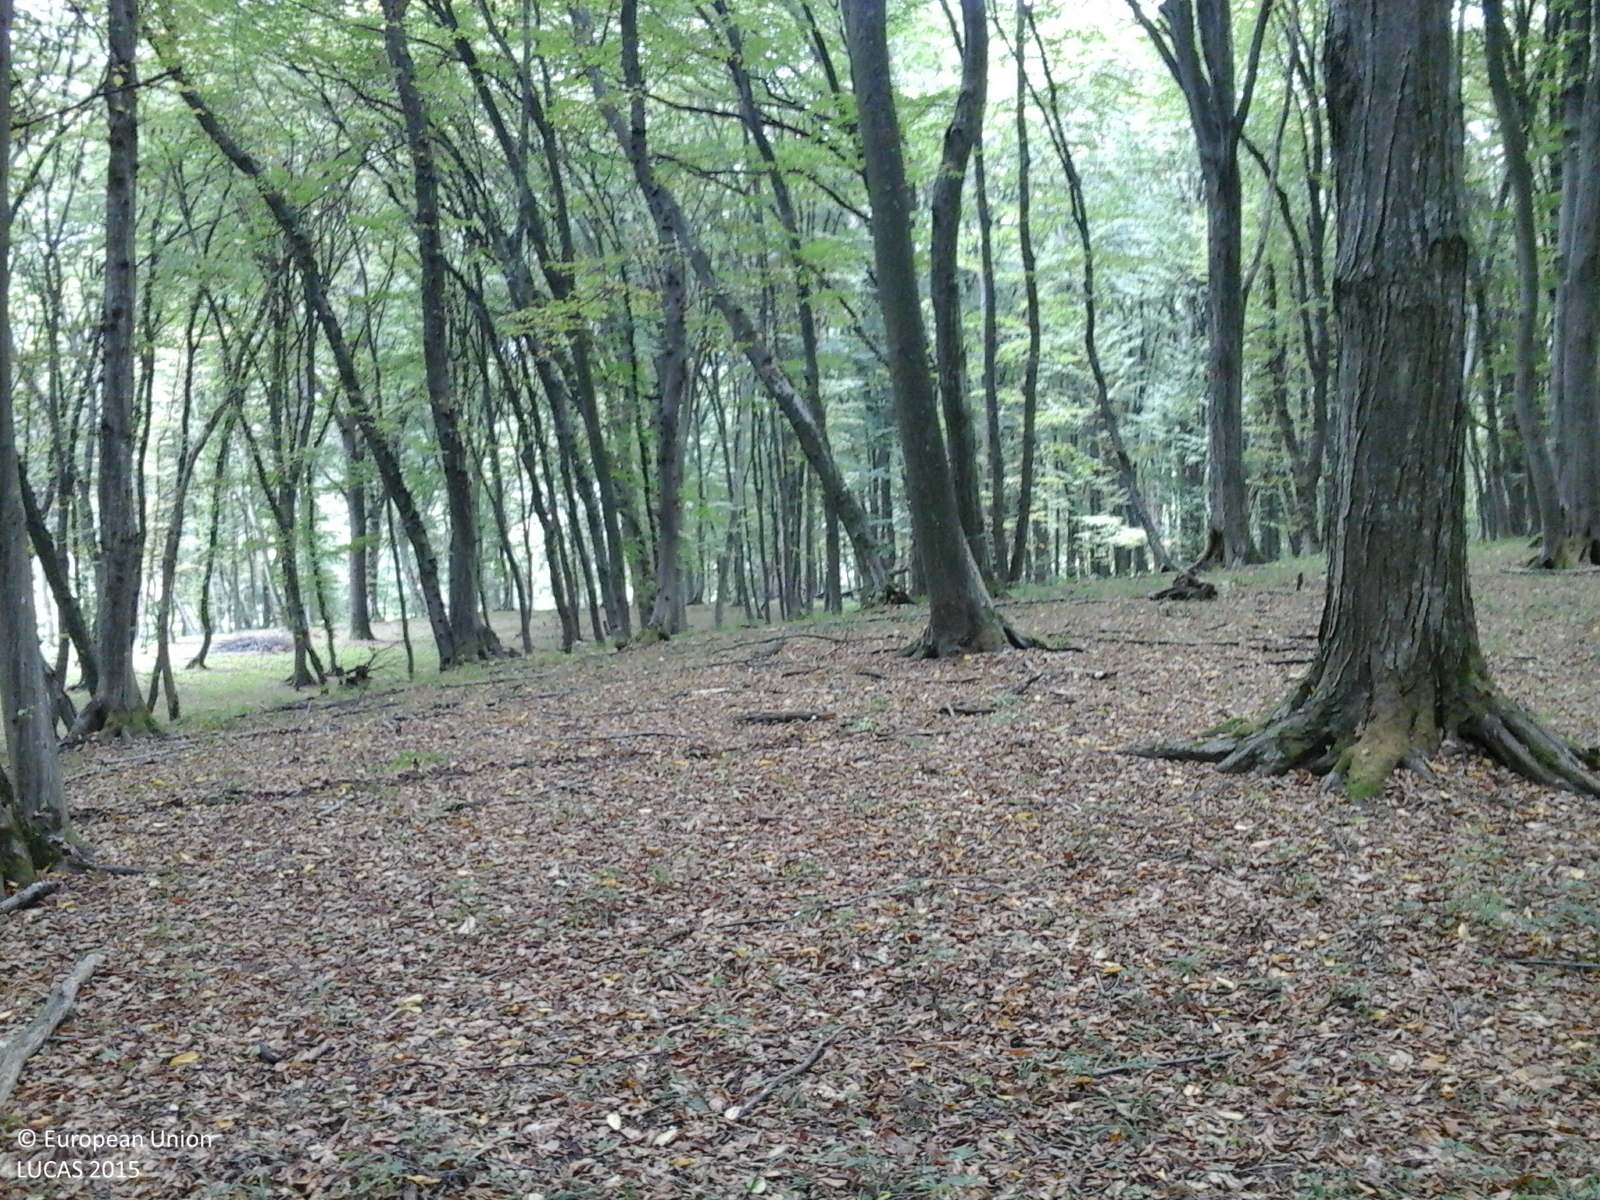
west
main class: Woodland
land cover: Broadleaved woodland
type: mesophytic deciduous forest
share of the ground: > 75 %
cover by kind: broadleaved forest trees 100 %
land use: Forestry
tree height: > 5 m
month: October
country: RO
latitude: 46.2568
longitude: 24.7360
